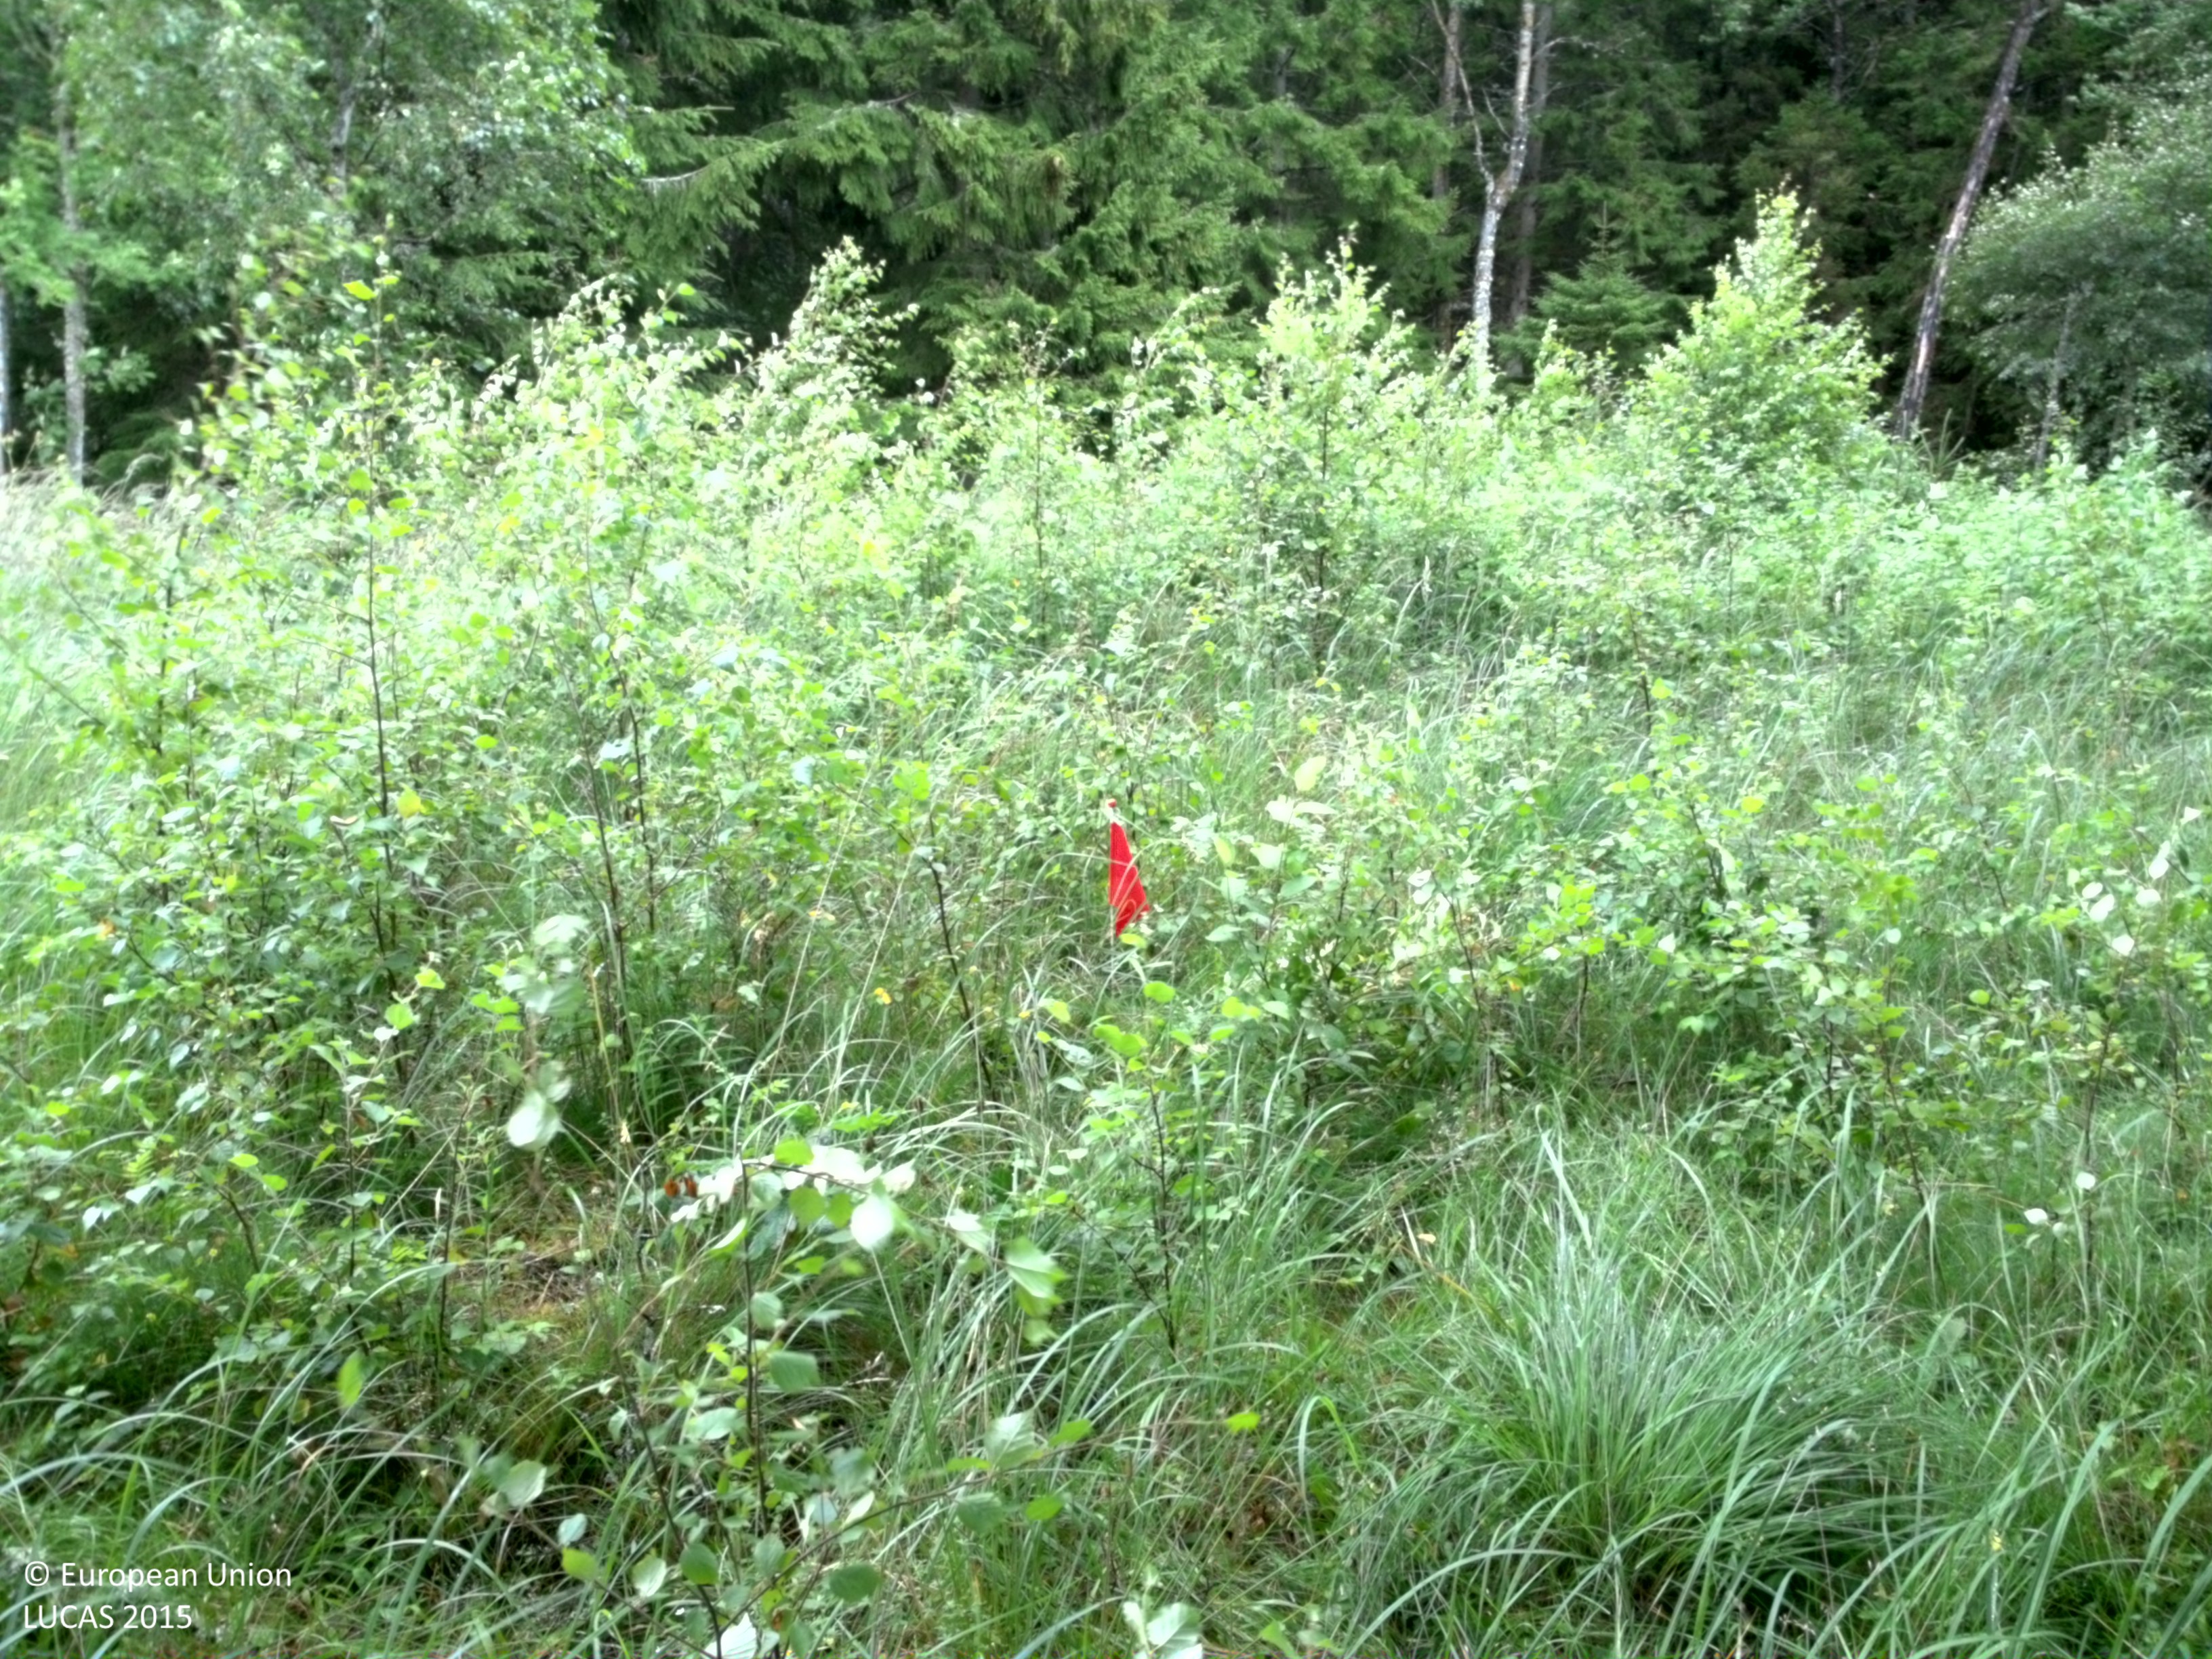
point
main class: Woodland
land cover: Broadleaved woodland
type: boreal forest
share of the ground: 50 - 75 %
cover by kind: broadleaved forest trees 70 %, herbaceous plants 20 %, coniferous forest trees 5 %, shrubs 5 %
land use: Forestry
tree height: > 5 m
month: July
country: SE
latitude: 58.3225
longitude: 13.3236
